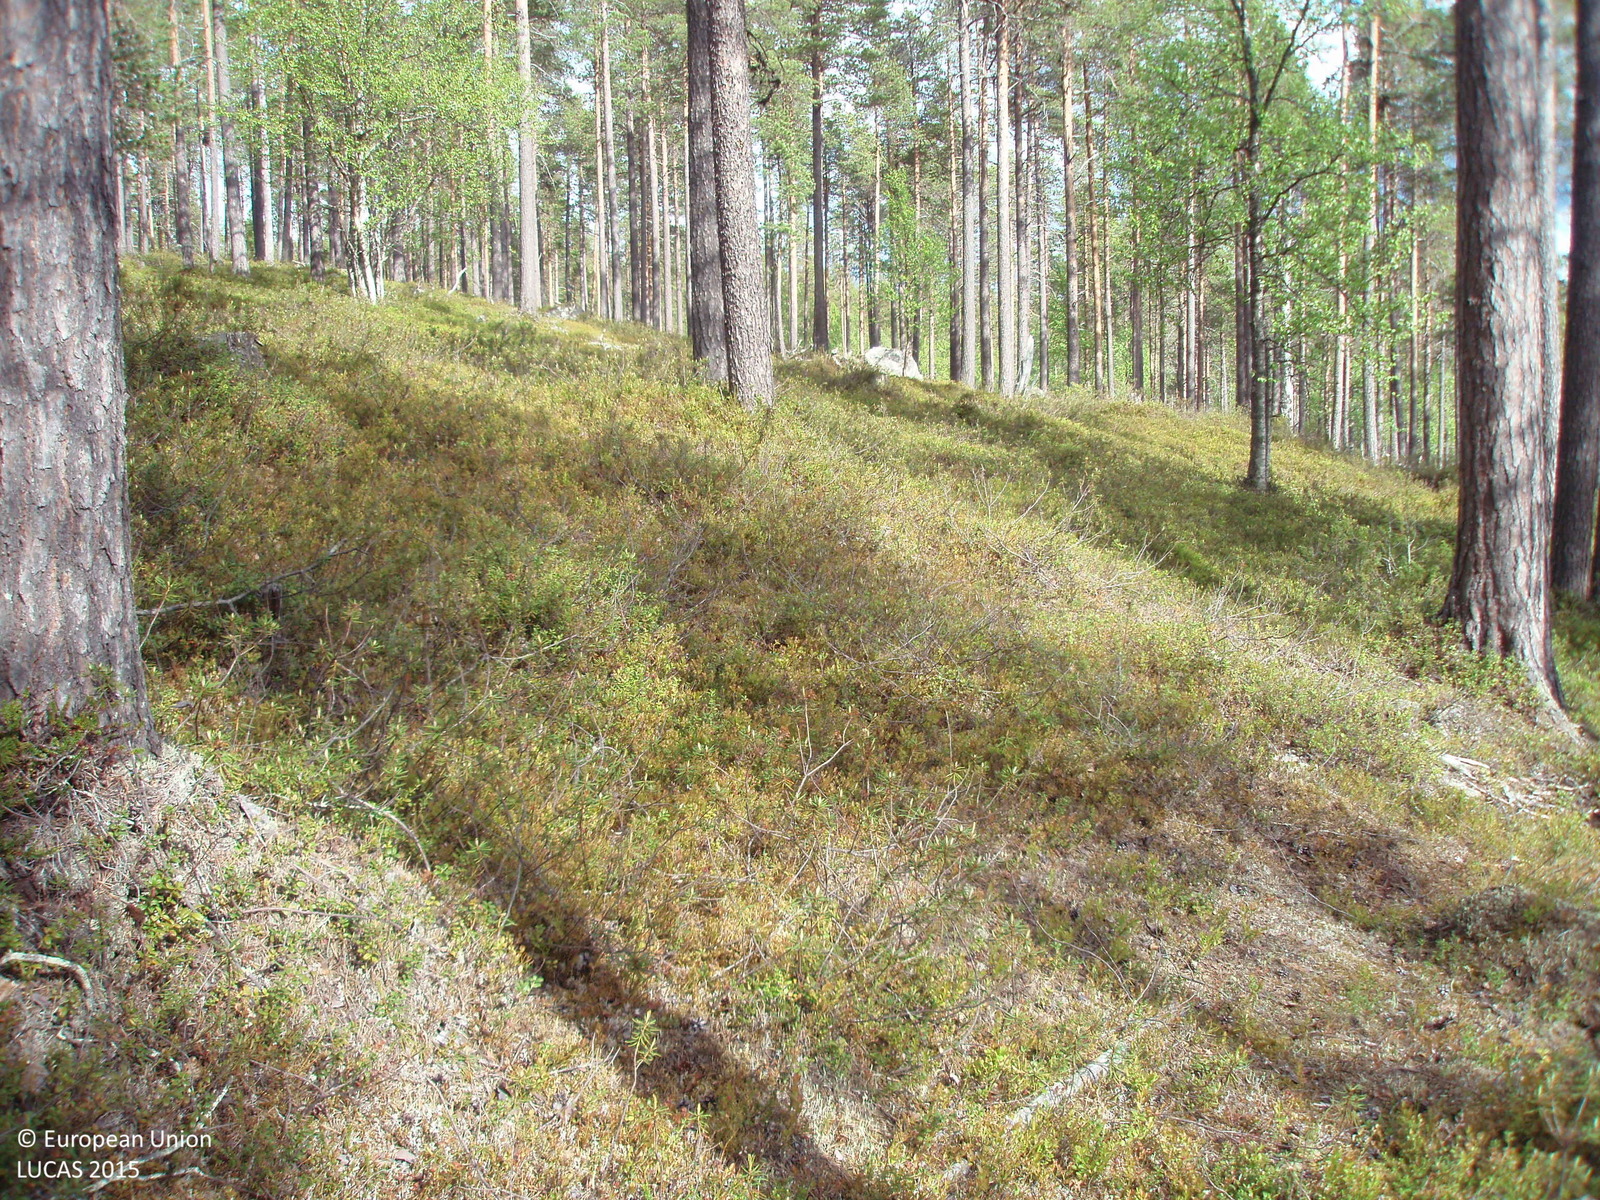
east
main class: Woodland
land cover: Pine dominated coniferous woodland
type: boreal forest
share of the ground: 50 - 75 %
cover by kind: coniferous forest trees 50 %, shrubs 35 %, broadleaved forest trees 10 %, lichens and mosses 5 %
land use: Forestry
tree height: > 5 m
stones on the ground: 25 - 50 %
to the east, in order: Pine dominated coniferous woodland; Pine dominated mixed woodland; Rock outcrops; Pine dominated mixed woodland
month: June
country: FI
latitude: 68.7596
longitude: 28.3793
